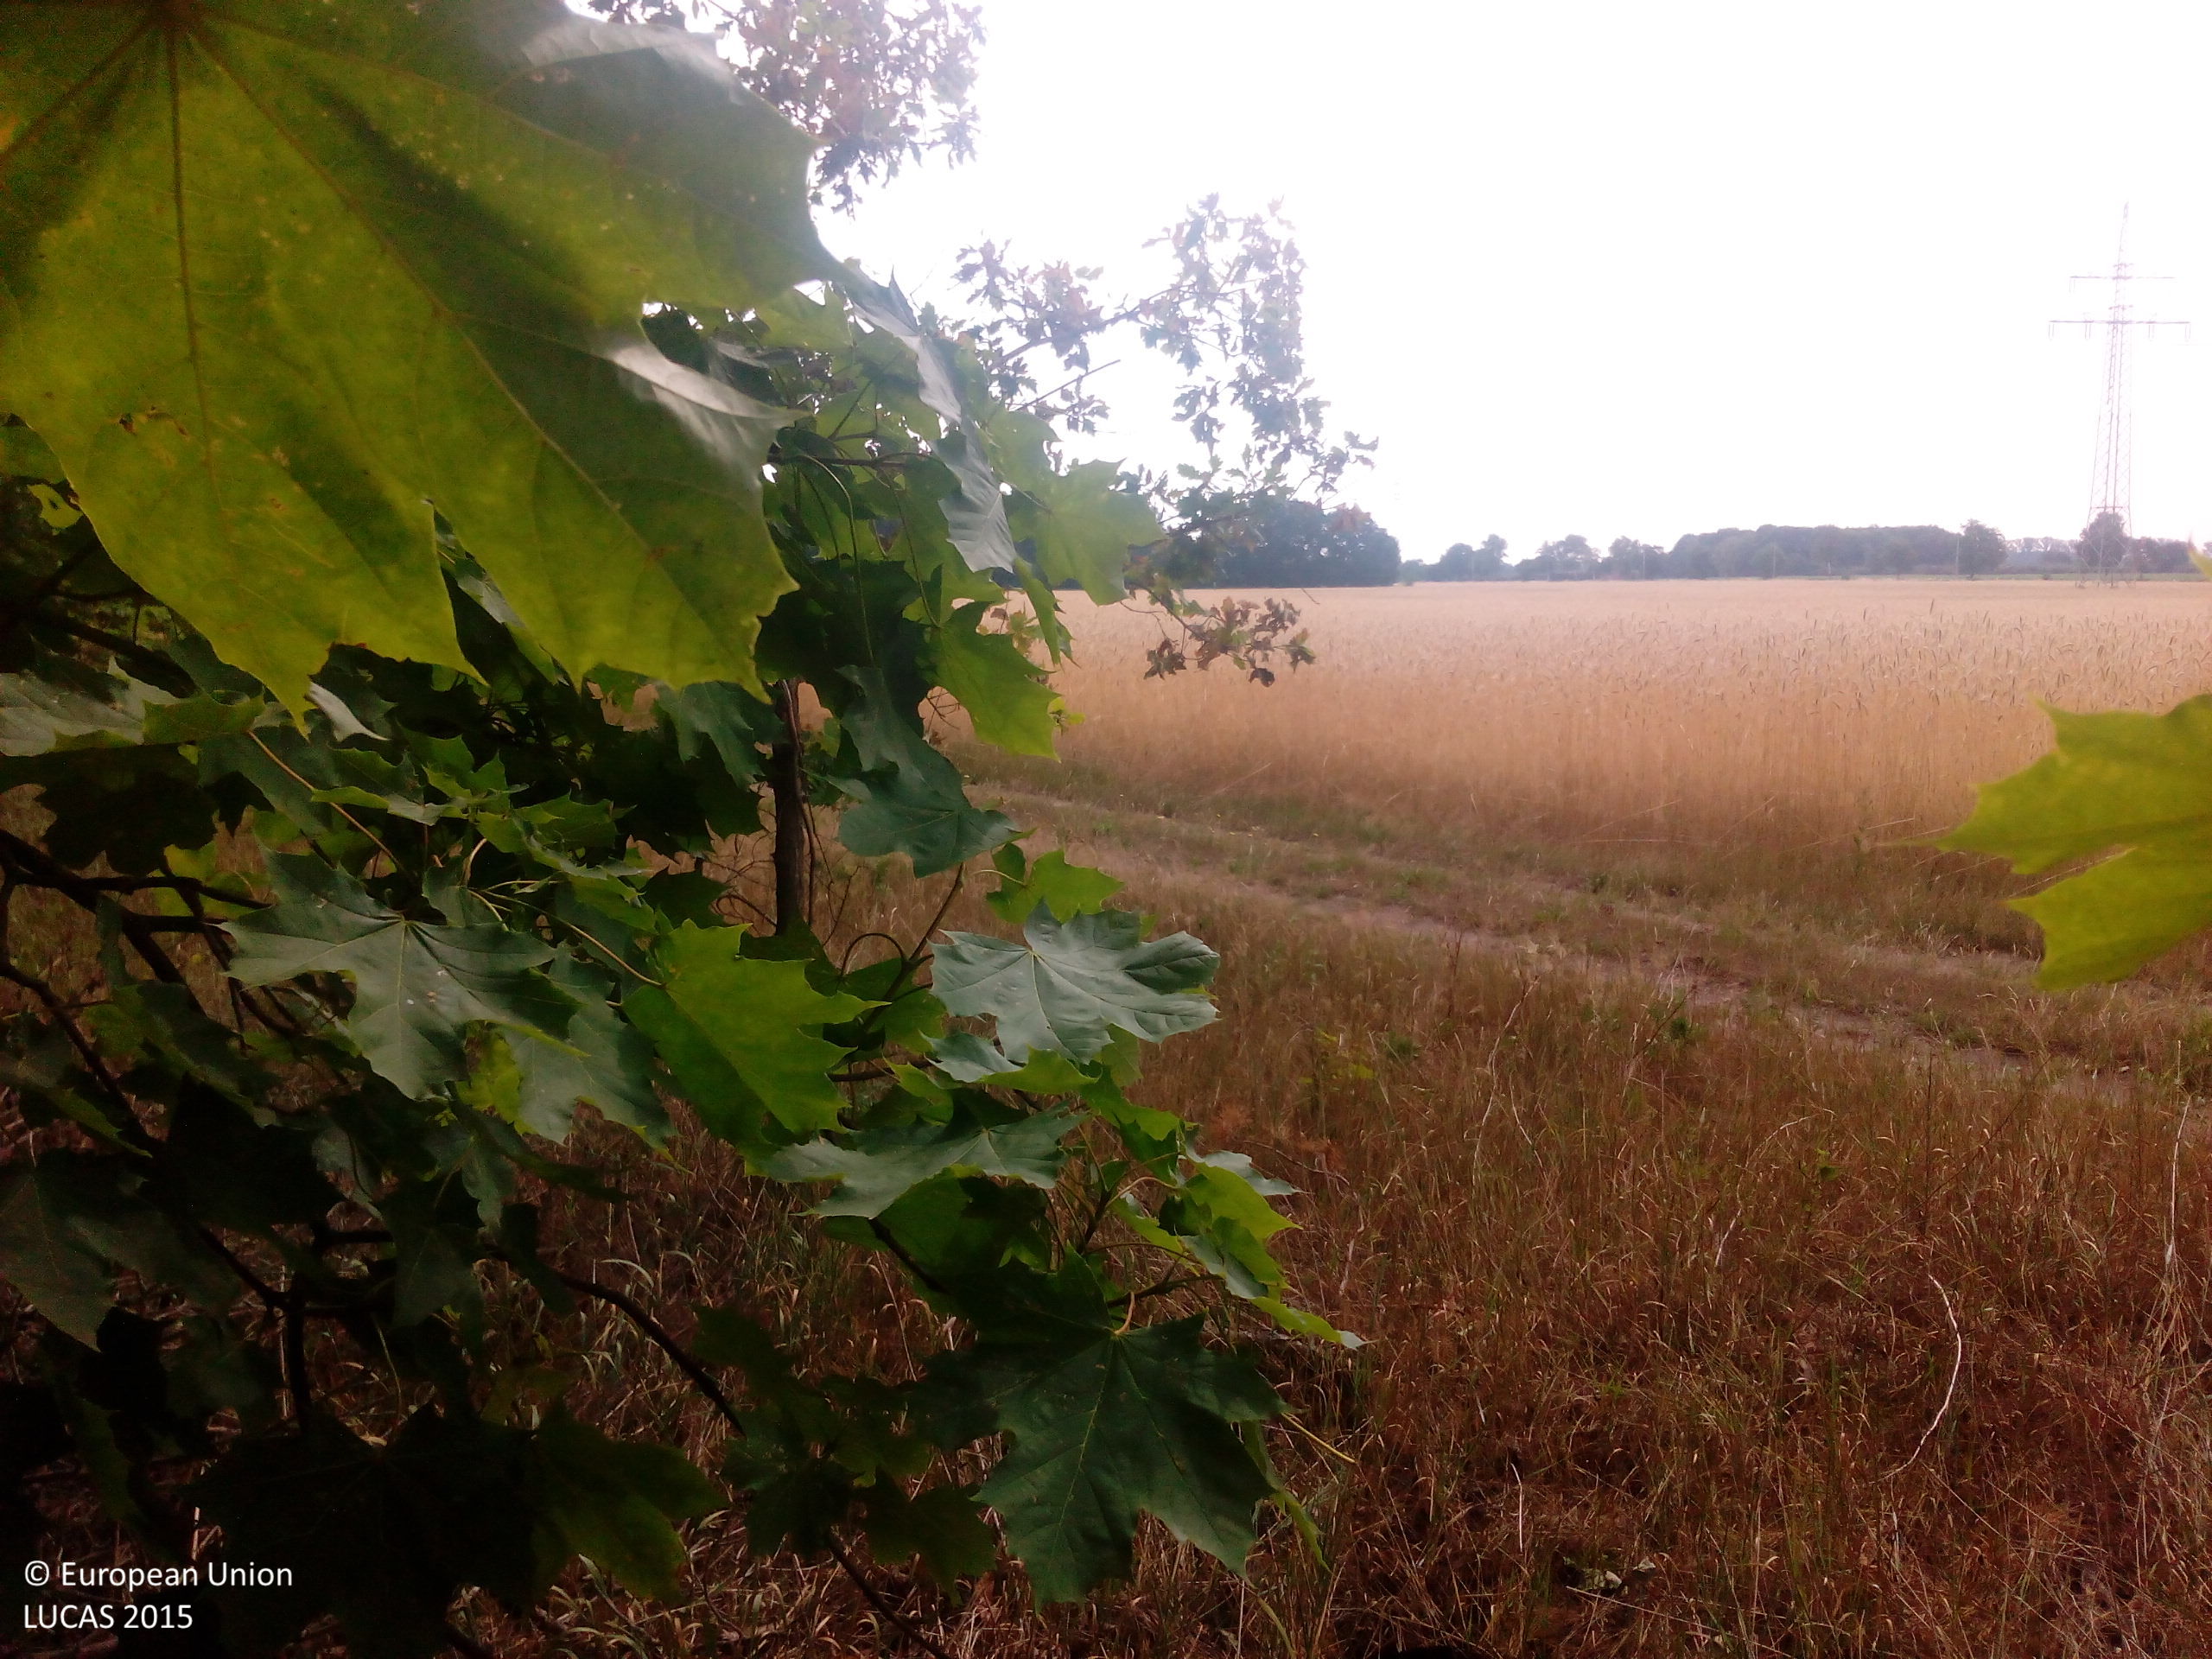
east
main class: Woodland
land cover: Pine dominated mixed woodland
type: hemiboreal forest and nemoral coniferous forest and mixed broadleaved-coniferous forest
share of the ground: > 75 %
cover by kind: coniferous forest trees 70 %, broadleaved forest trees 30 %
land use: Forestry
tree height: > 5 m
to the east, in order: Pine dominated mixed woodland; Grass margins; Tracks; Grass margins; Rye
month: July
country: DE
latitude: 52.5698
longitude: 11.1357
